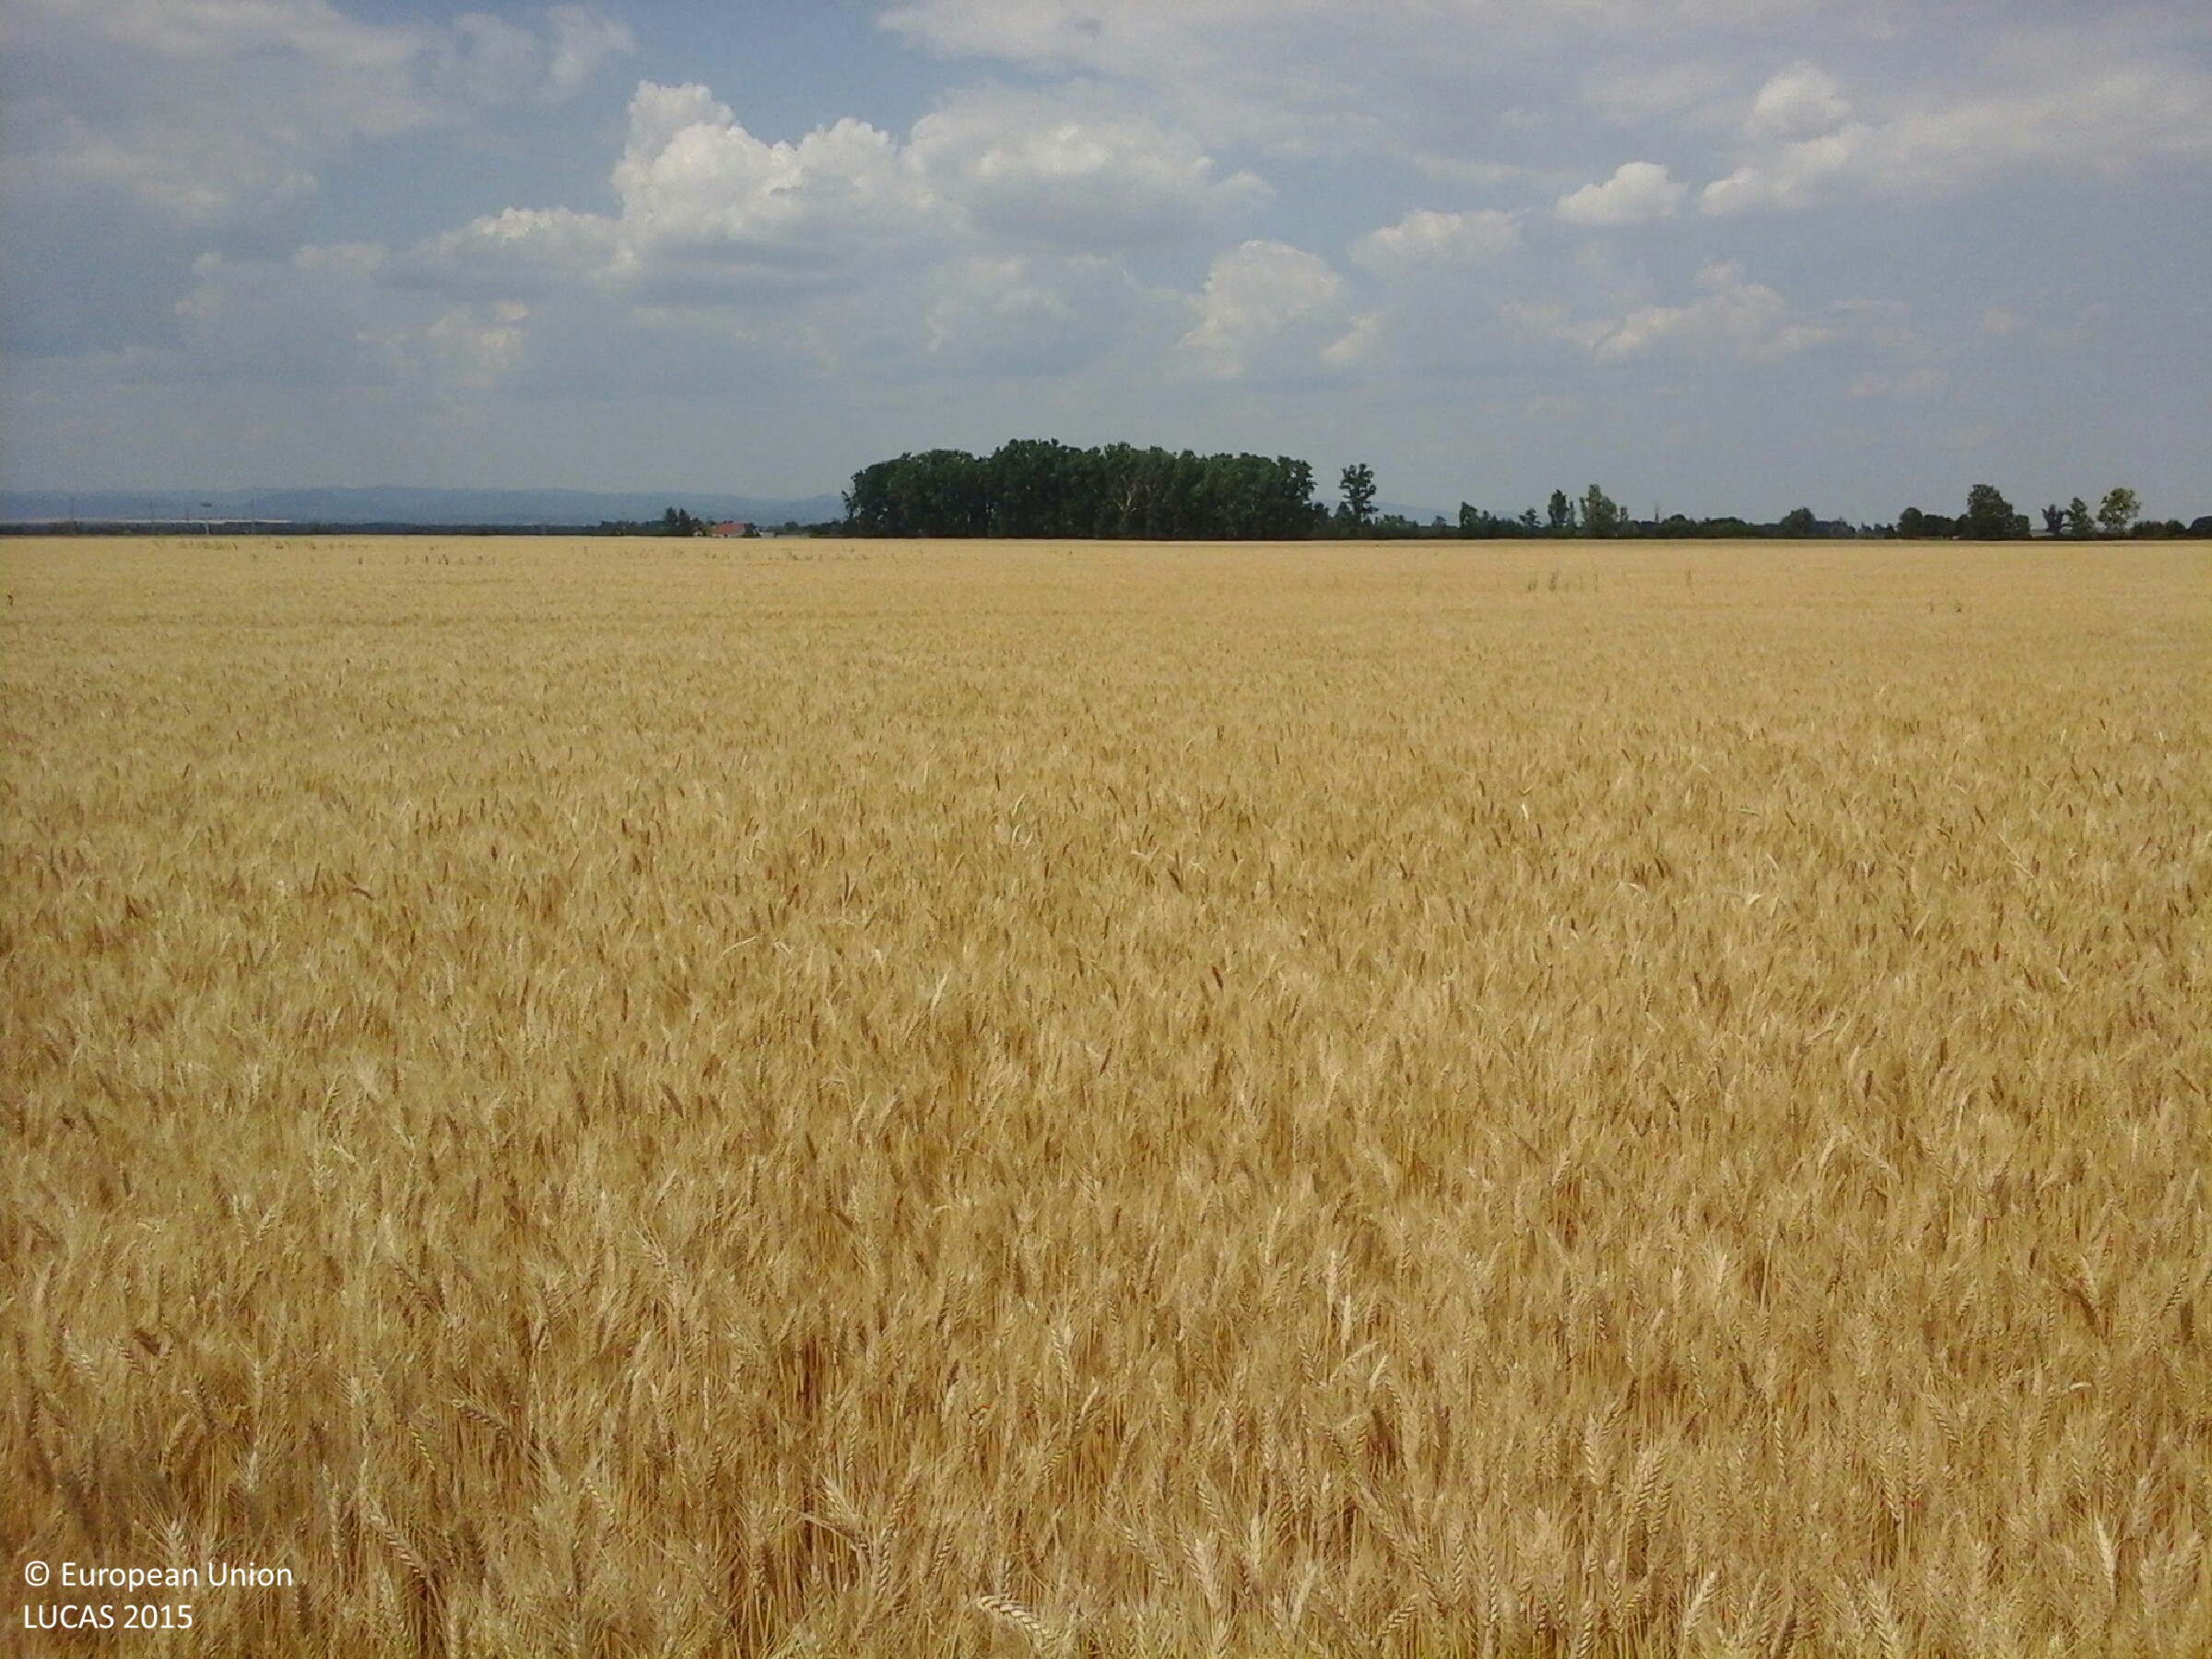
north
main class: Cropland
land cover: Common wheat
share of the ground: > 75 %
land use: Agriculture (excluding fallow land and kitchen gardens)
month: July
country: HU
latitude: 47.7767
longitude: 20.6703
